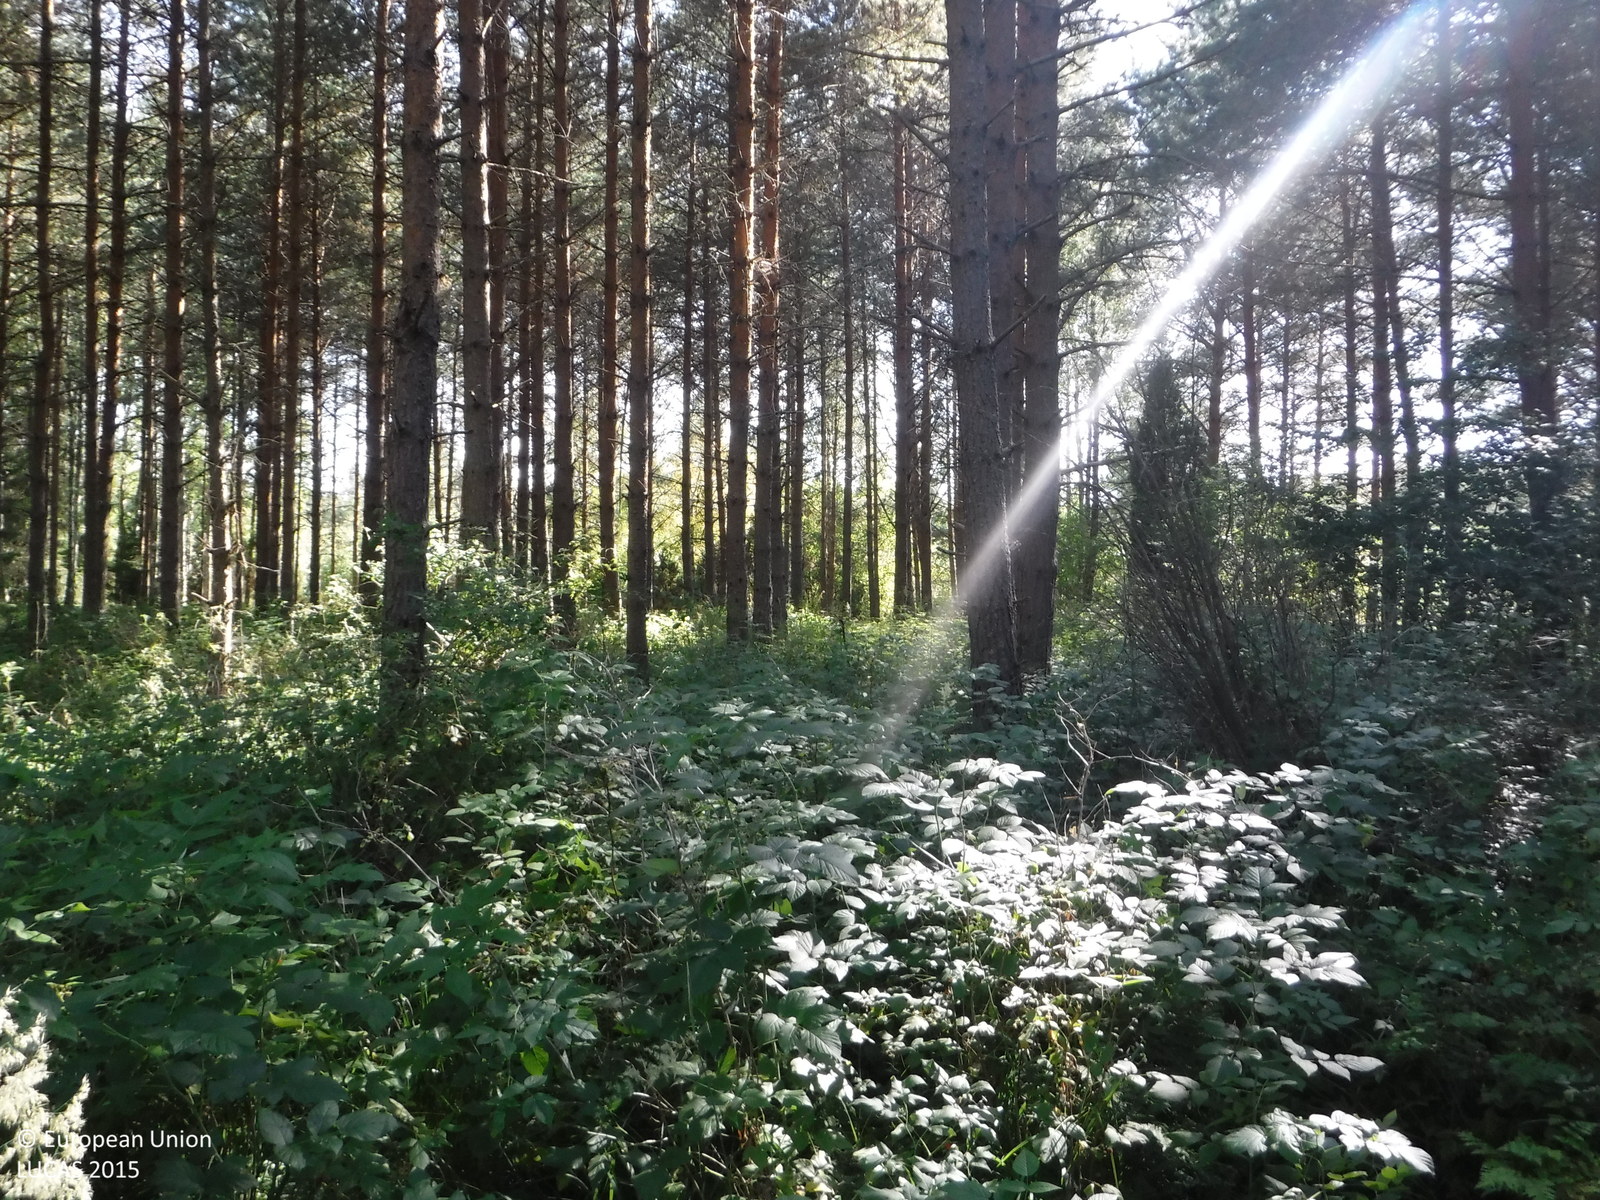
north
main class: Woodland
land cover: Pine dominated coniferous woodland
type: boreal forest
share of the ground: 50 - 75 %
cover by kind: coniferous forest trees 65 %, shrubs 30 %, herbaceous plants 5 %
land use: Forestry
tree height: > 5 m
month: August
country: FI
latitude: 61.0823
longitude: 21.4165
